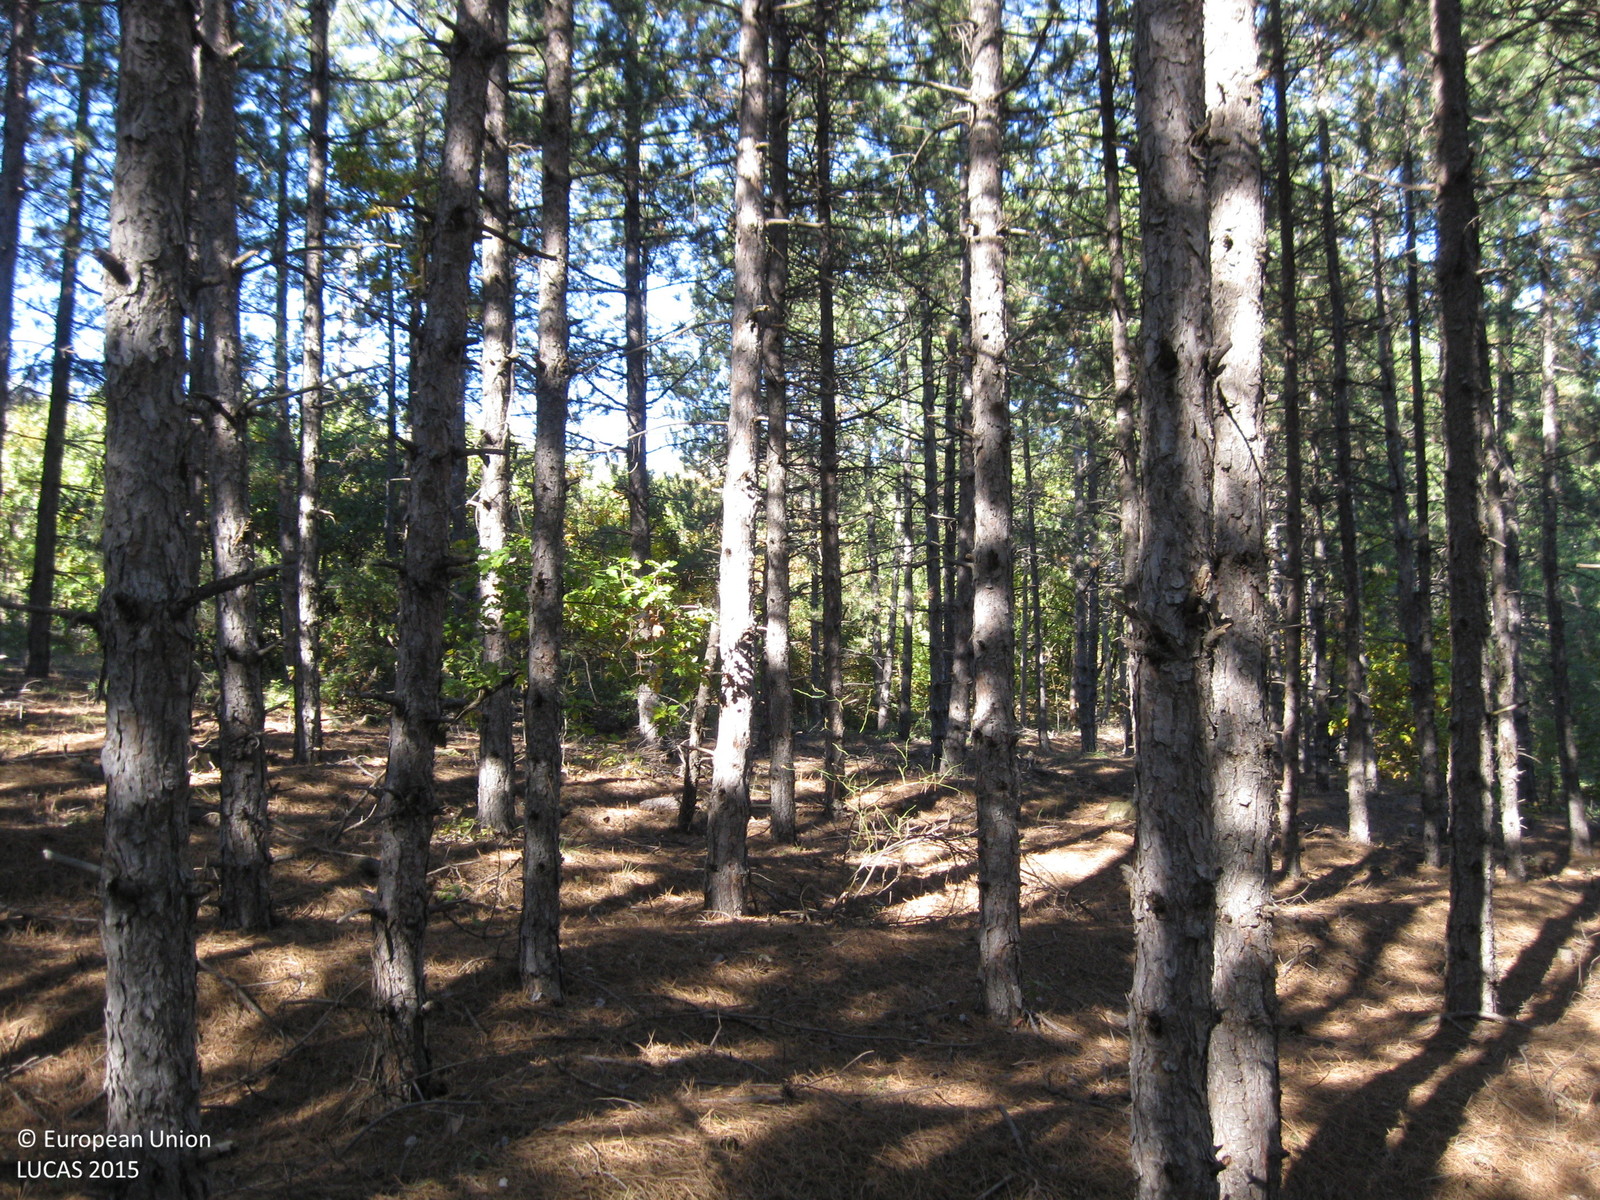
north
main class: Woodland
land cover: Pine dominated coniferous woodland
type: hemiboreal forest and nemoral coniferous forest and mixed broadleaved-coniferous forest
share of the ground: > 75 %
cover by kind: coniferous forest trees 95 %, unconsolidated bare surface 5 %
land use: Forestry
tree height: > 5 m
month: November
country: BG
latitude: 42.3346
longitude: 24.1336
